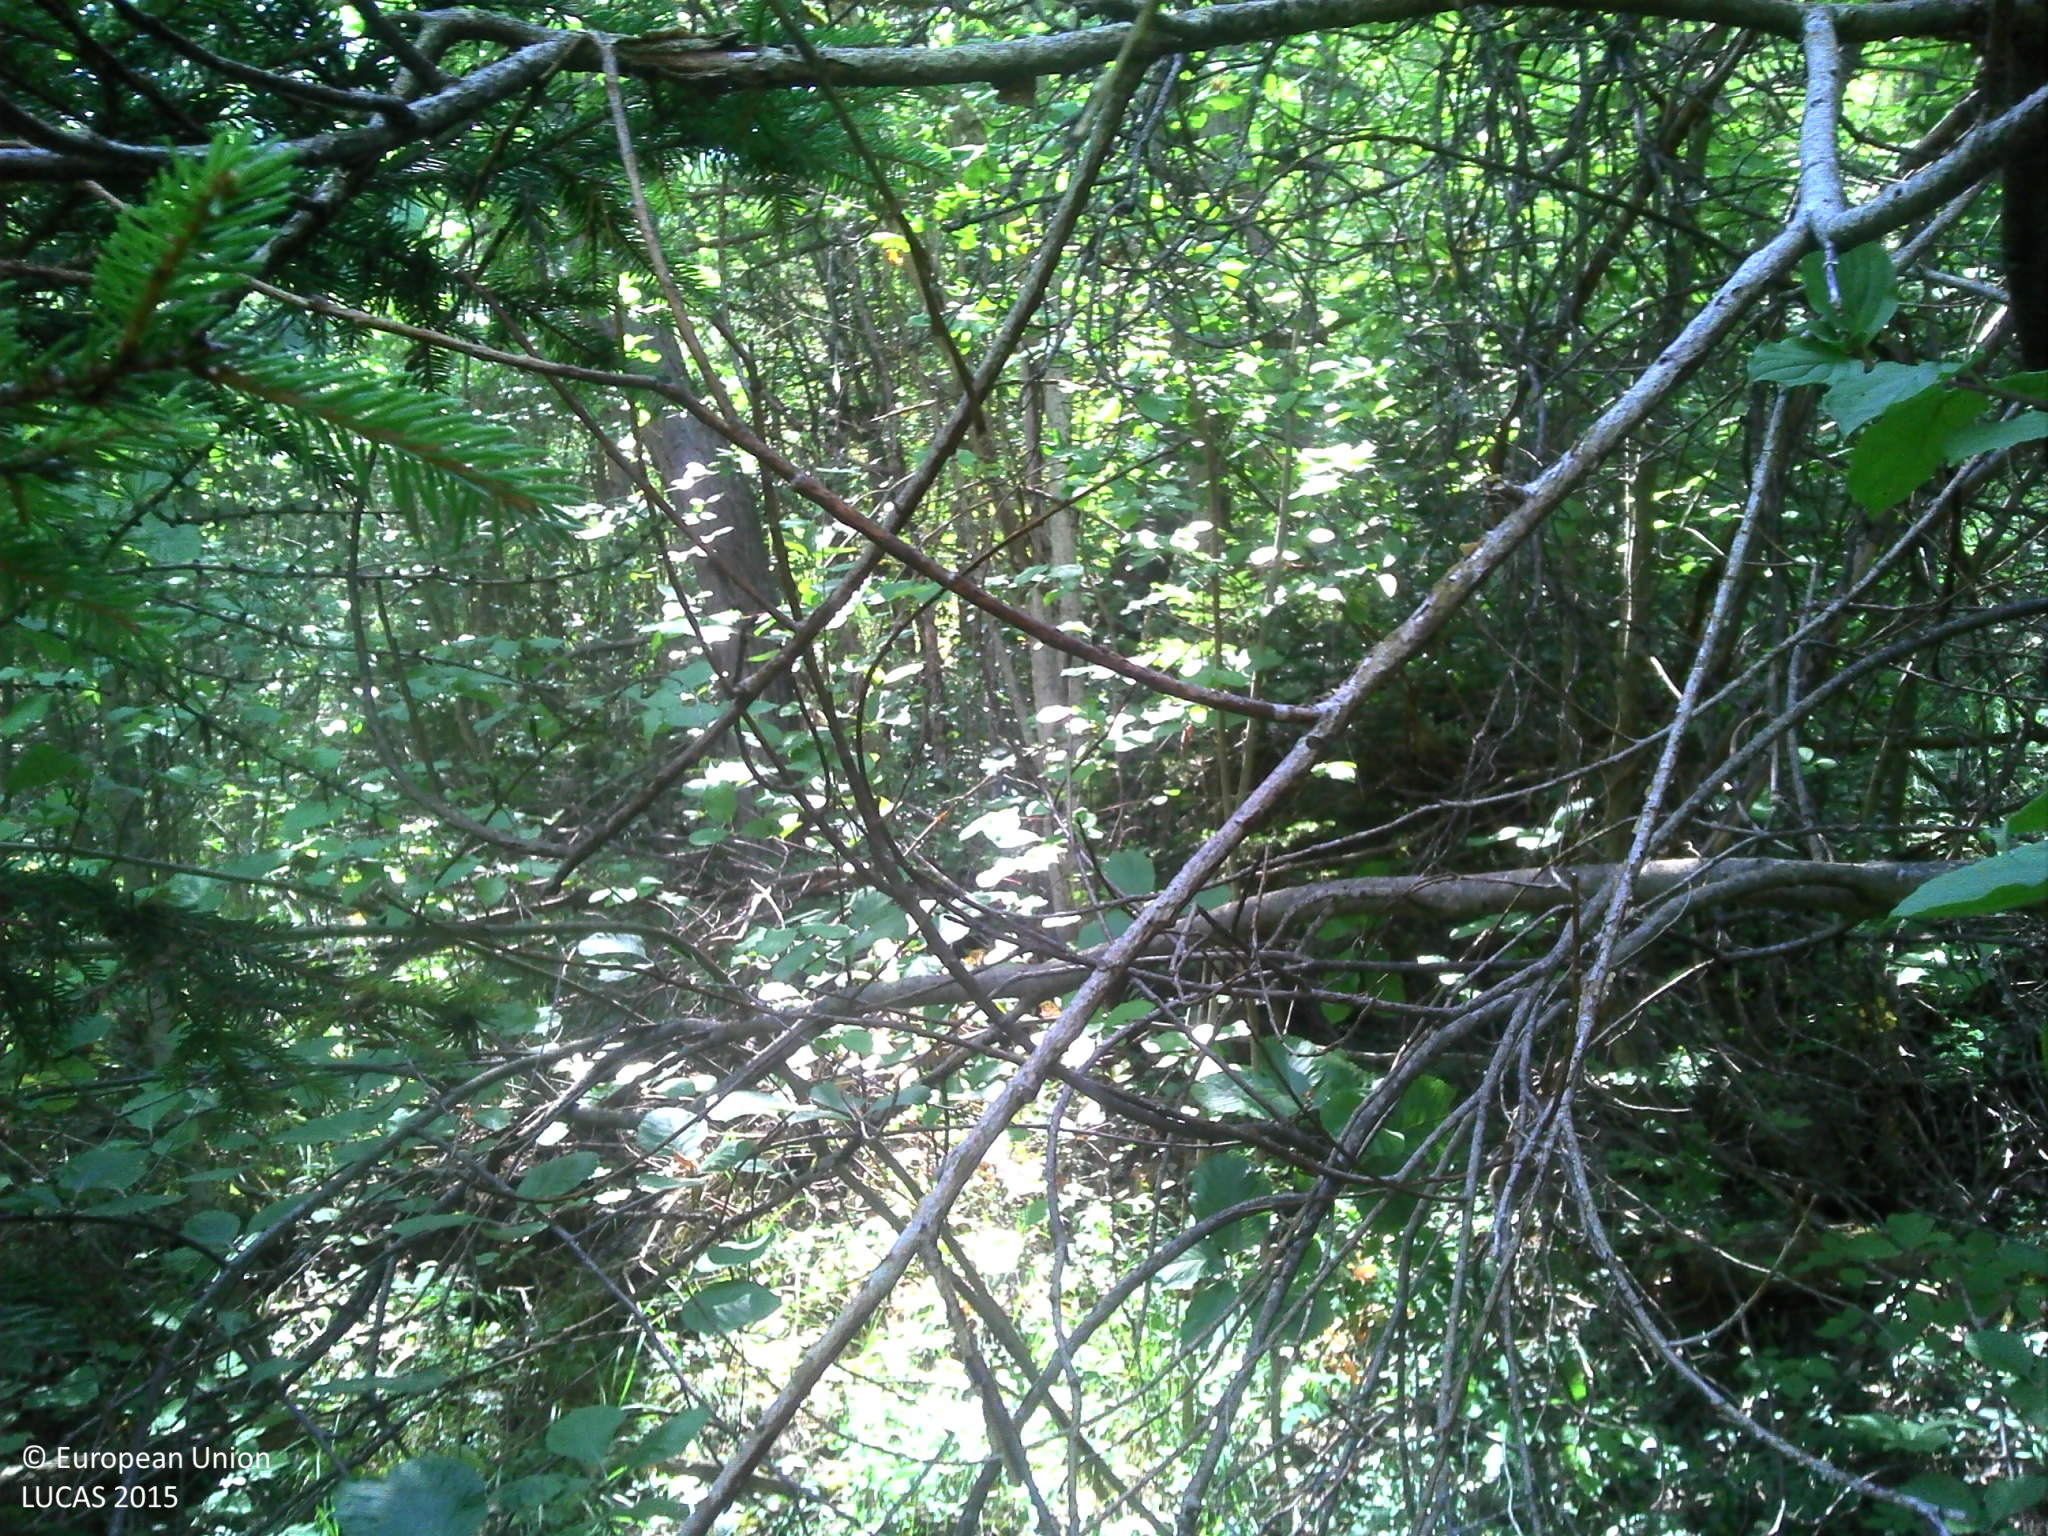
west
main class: Woodland
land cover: Pine dominated mixed woodland
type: alpine coniferous forest
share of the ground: > 75 %
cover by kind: coniferous forest trees 40 %, broadleaved forest trees 40 %, shrubs 10 %, herbaceous plants 10 %
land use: Forestry
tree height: > 5 m
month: August
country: FR
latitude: 44.3845
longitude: 6.5798
